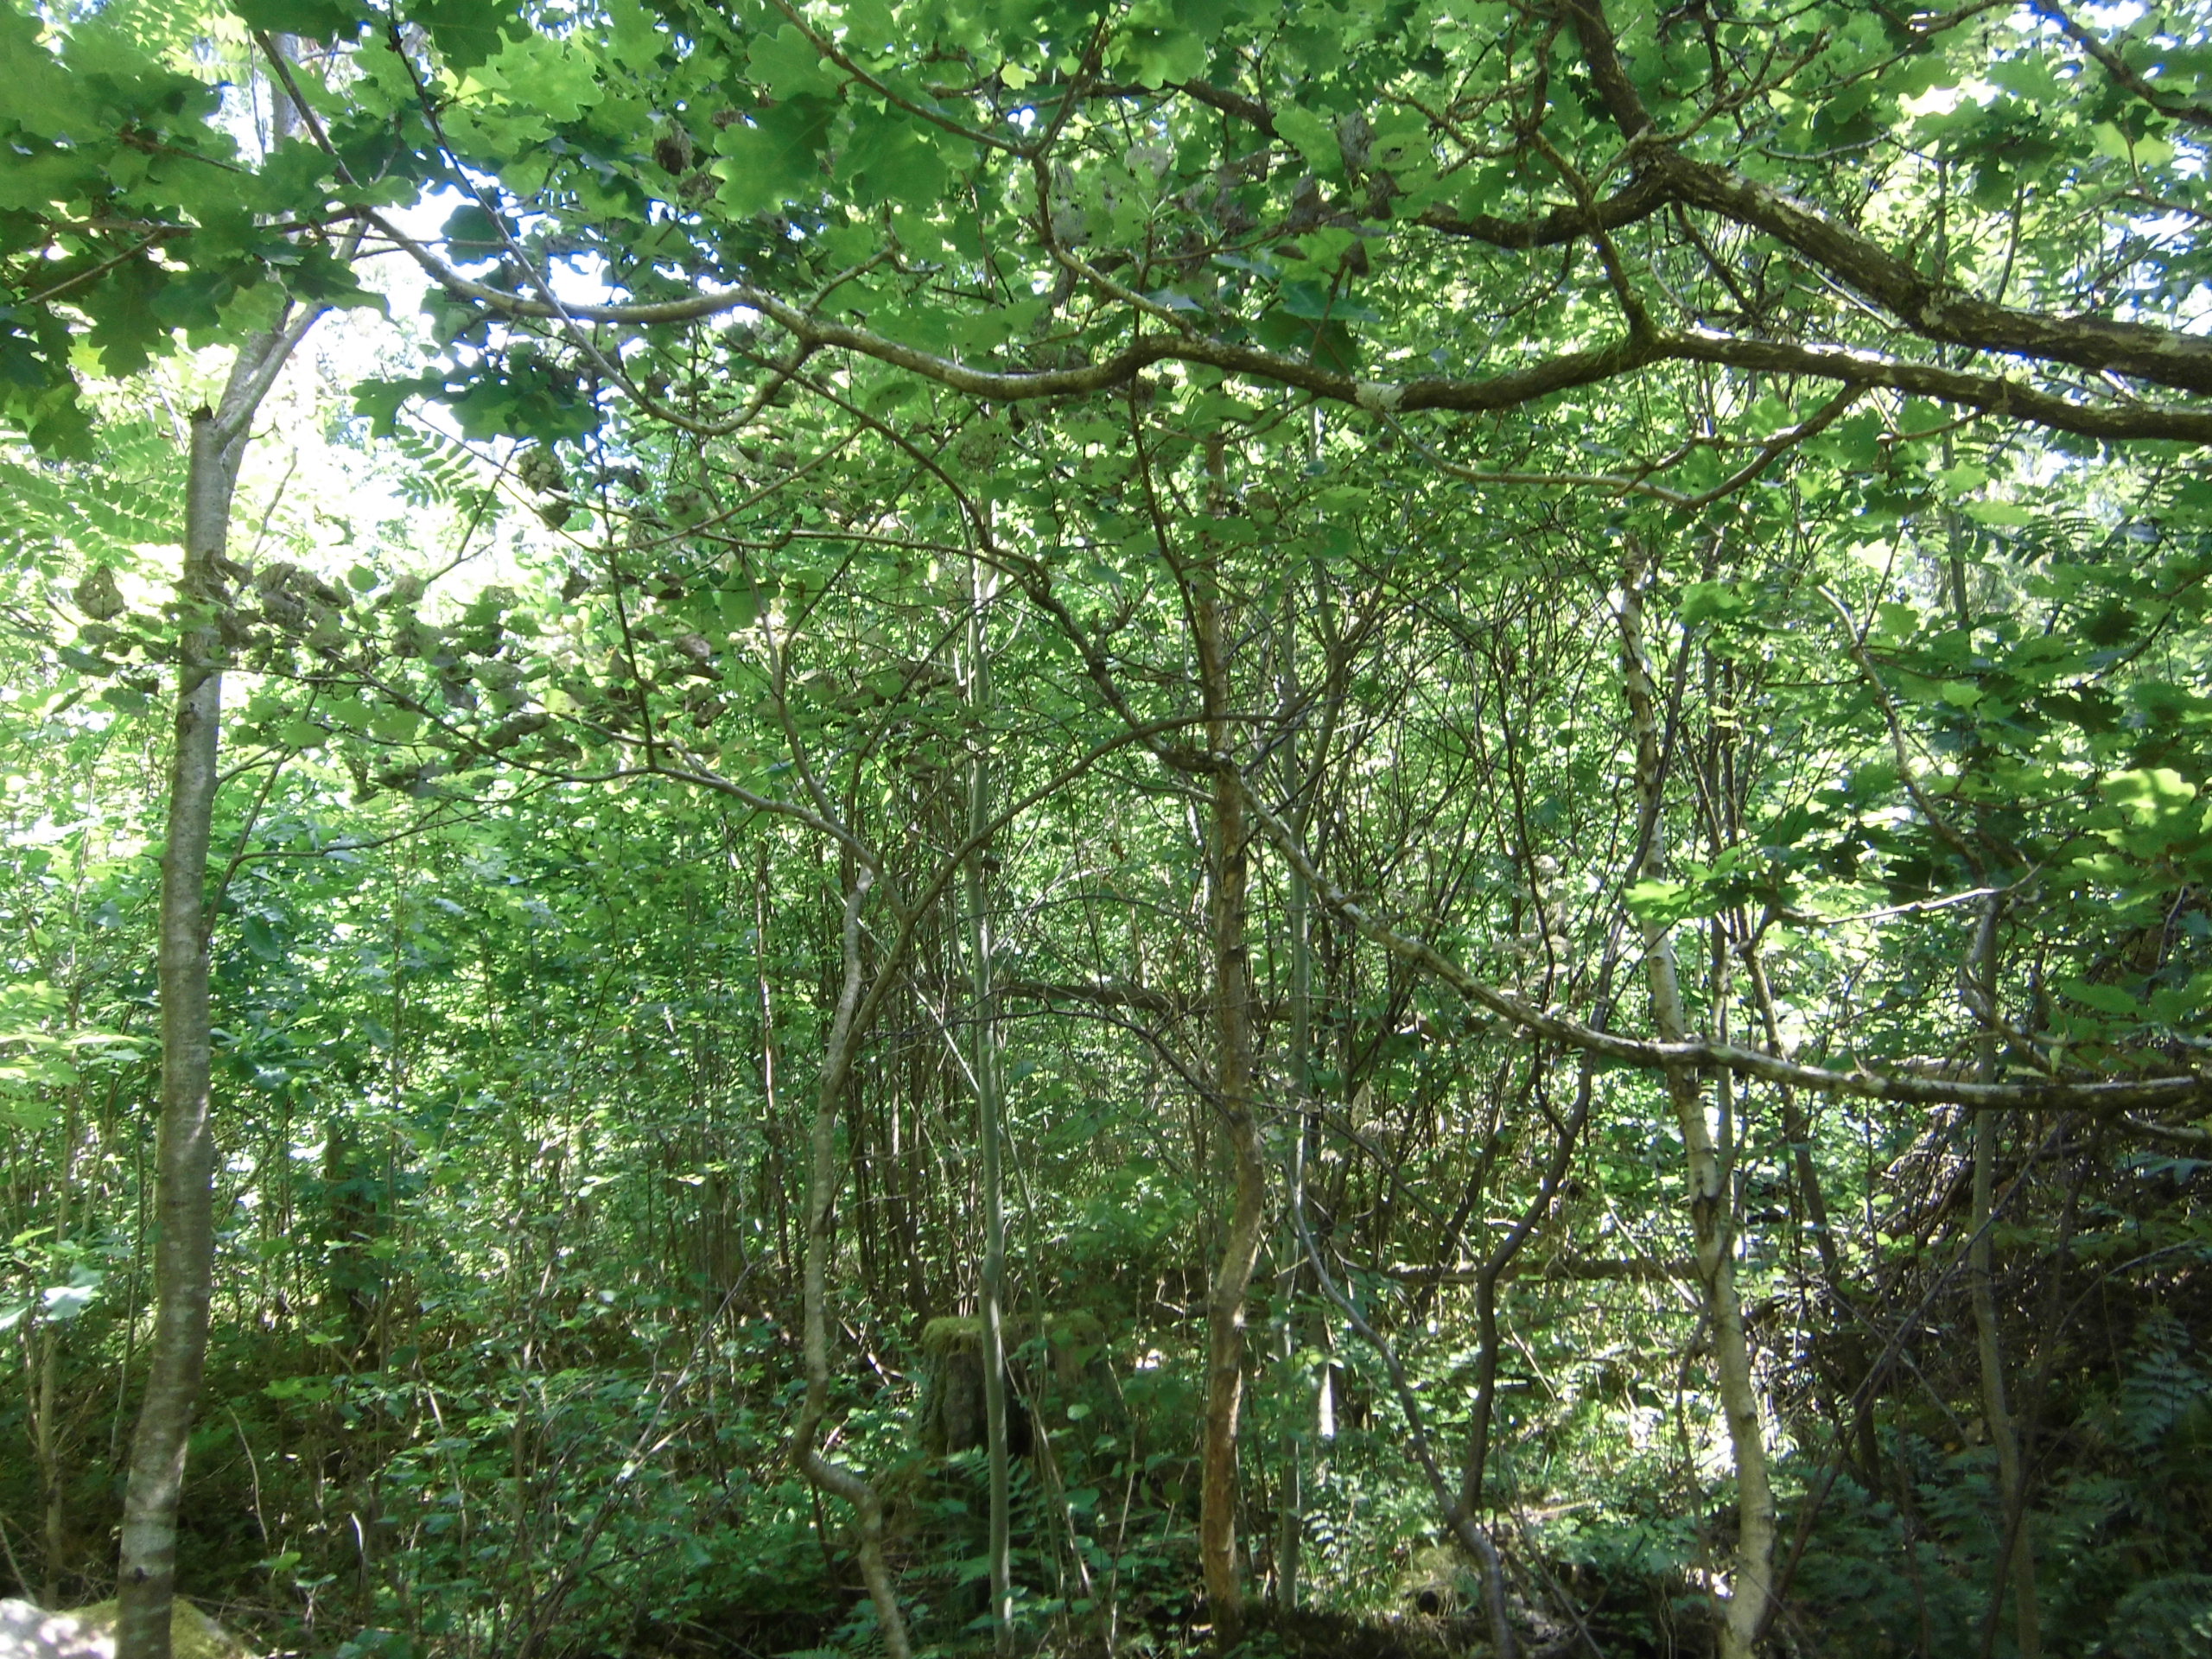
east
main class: Woodland
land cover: Spruce dominated mixed woodland
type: boreal forest
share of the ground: > 75 %
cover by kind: broadleaved forest trees 45 %, coniferous forest trees 30 %, herbaceous plants 15 %, shrubs 5 %, lichens and mosses 5 %
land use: Forestry
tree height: > 5 m
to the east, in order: Spruce dominated mixed woodland; Pine dominated mixed woodland; Tracks; Spruce dominated mixed woodland; Broadleaved woodland; Fences; Broadleaved woodland; Artificial constructions in urban areas; Grassland without tree/shrub cover; Electric lines; Fences; Ditches and canals; Paved roads, cycling and walking lanes; Grass margins; Fences; Groves; Artificial constructions in urban areas; Grassland without tree/shrub cover
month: July
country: SE
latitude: 57.3413
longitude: 15.2638
